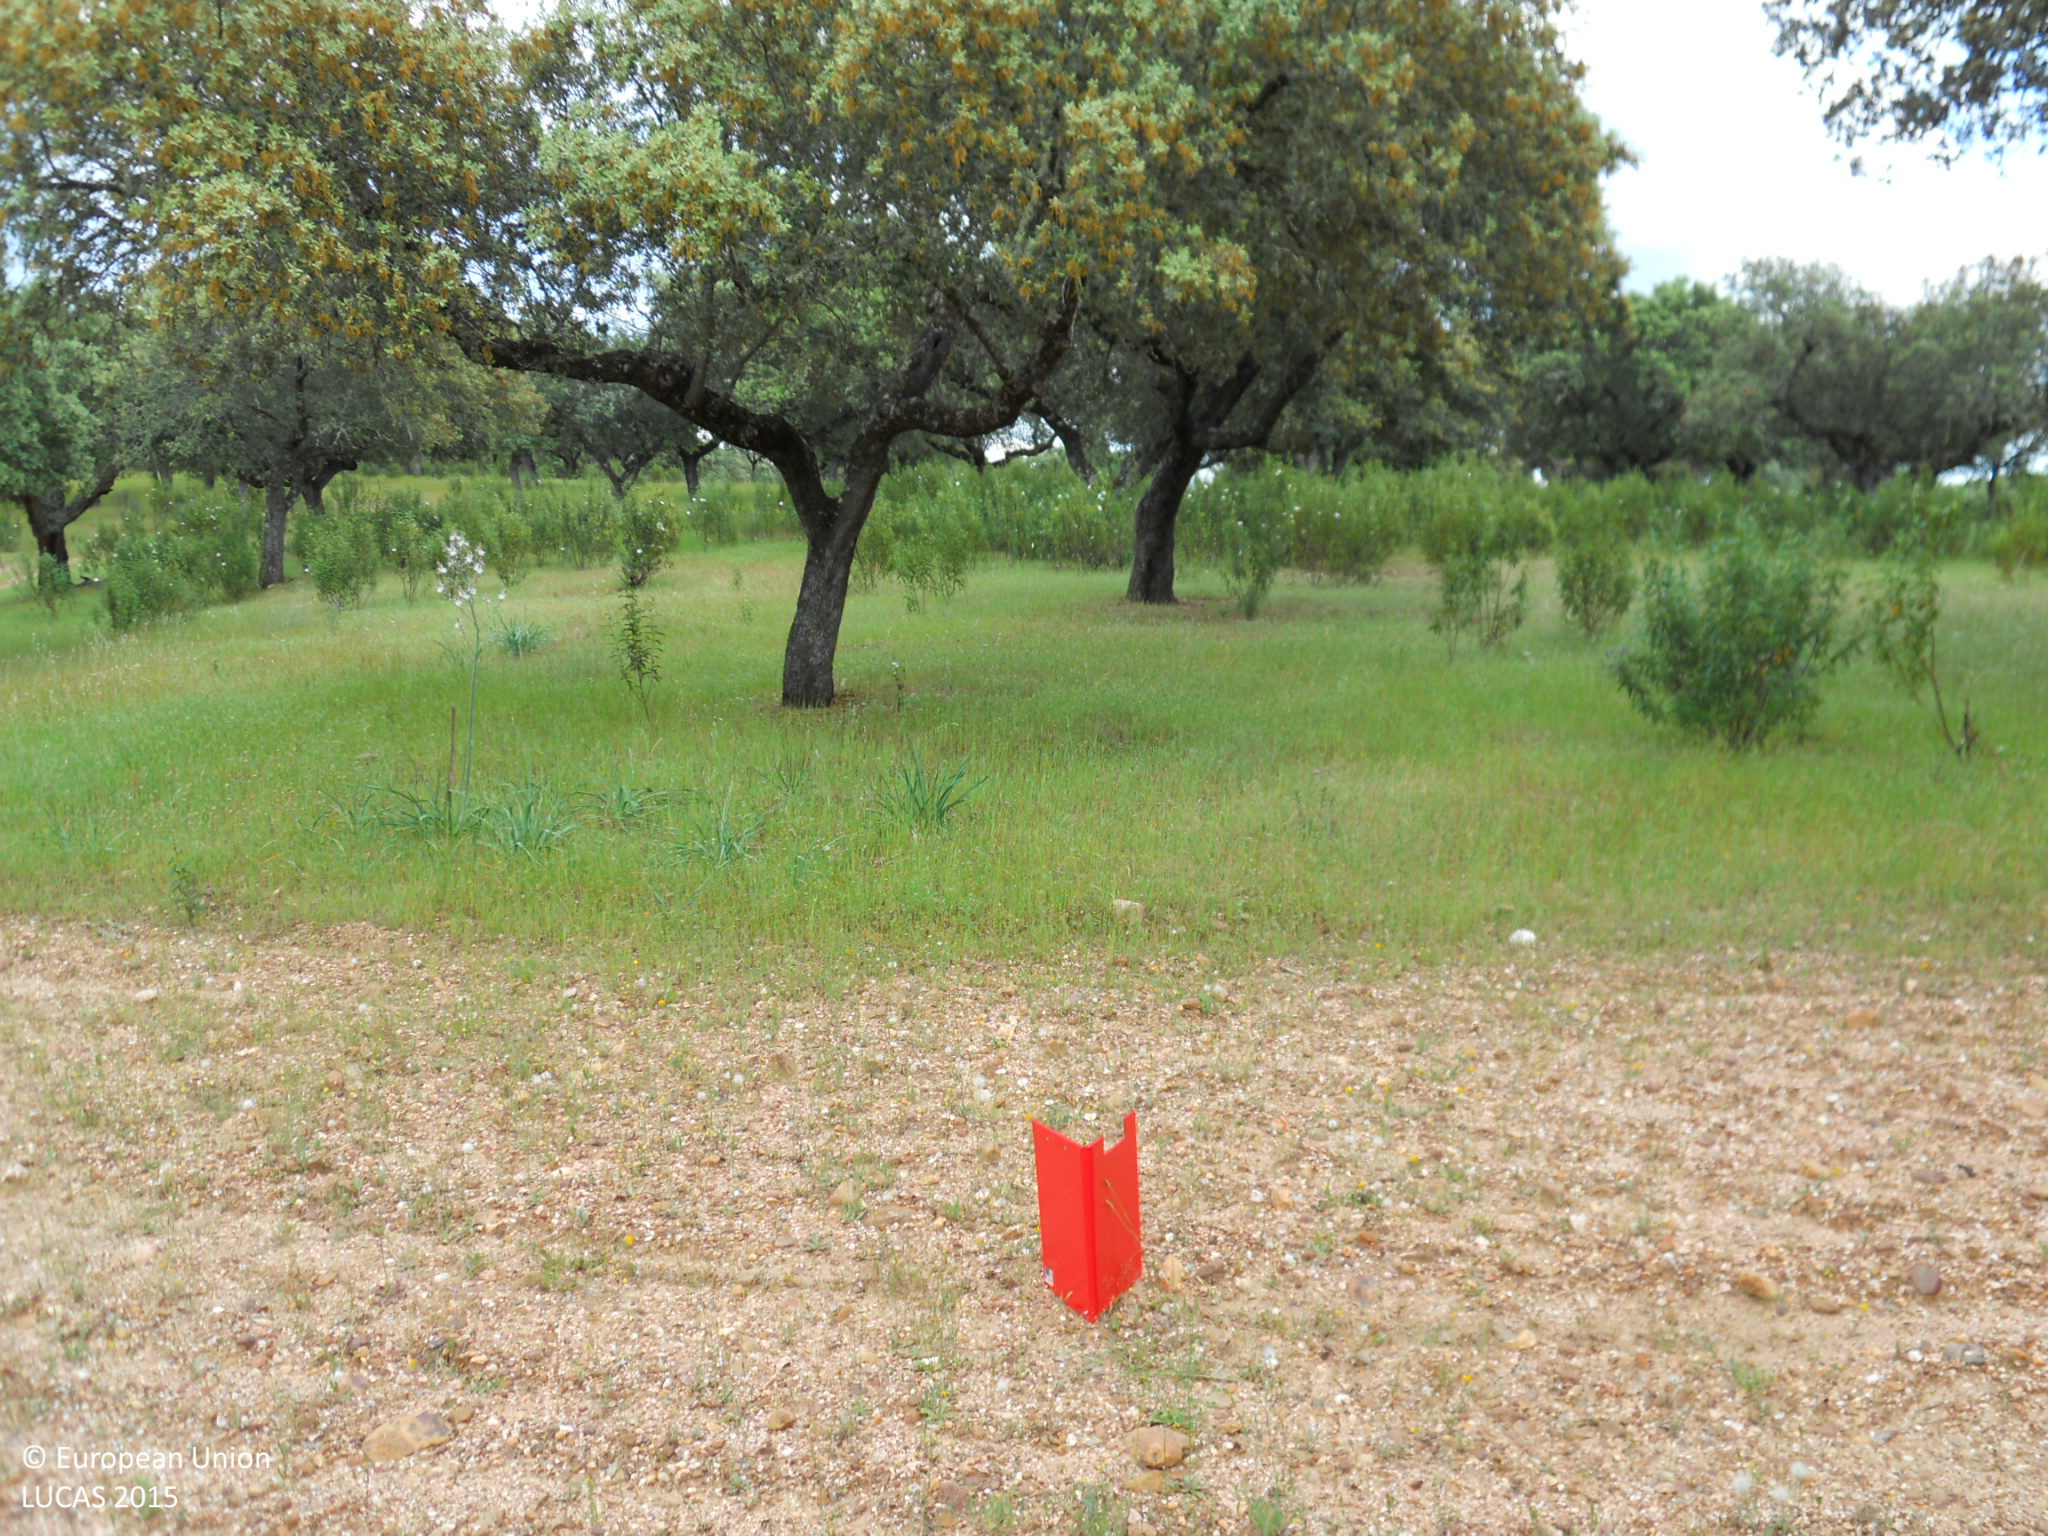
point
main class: Woodland
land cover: Broadleaved woodland
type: broadleaved evergreen forest
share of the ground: > 75 %
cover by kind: broadleaved forest trees 90 %, shrubs 5 %, consolidated bare surface 5 %
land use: Forestry
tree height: > 5 m
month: April
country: ES
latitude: 39.3073
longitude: -6.7849
